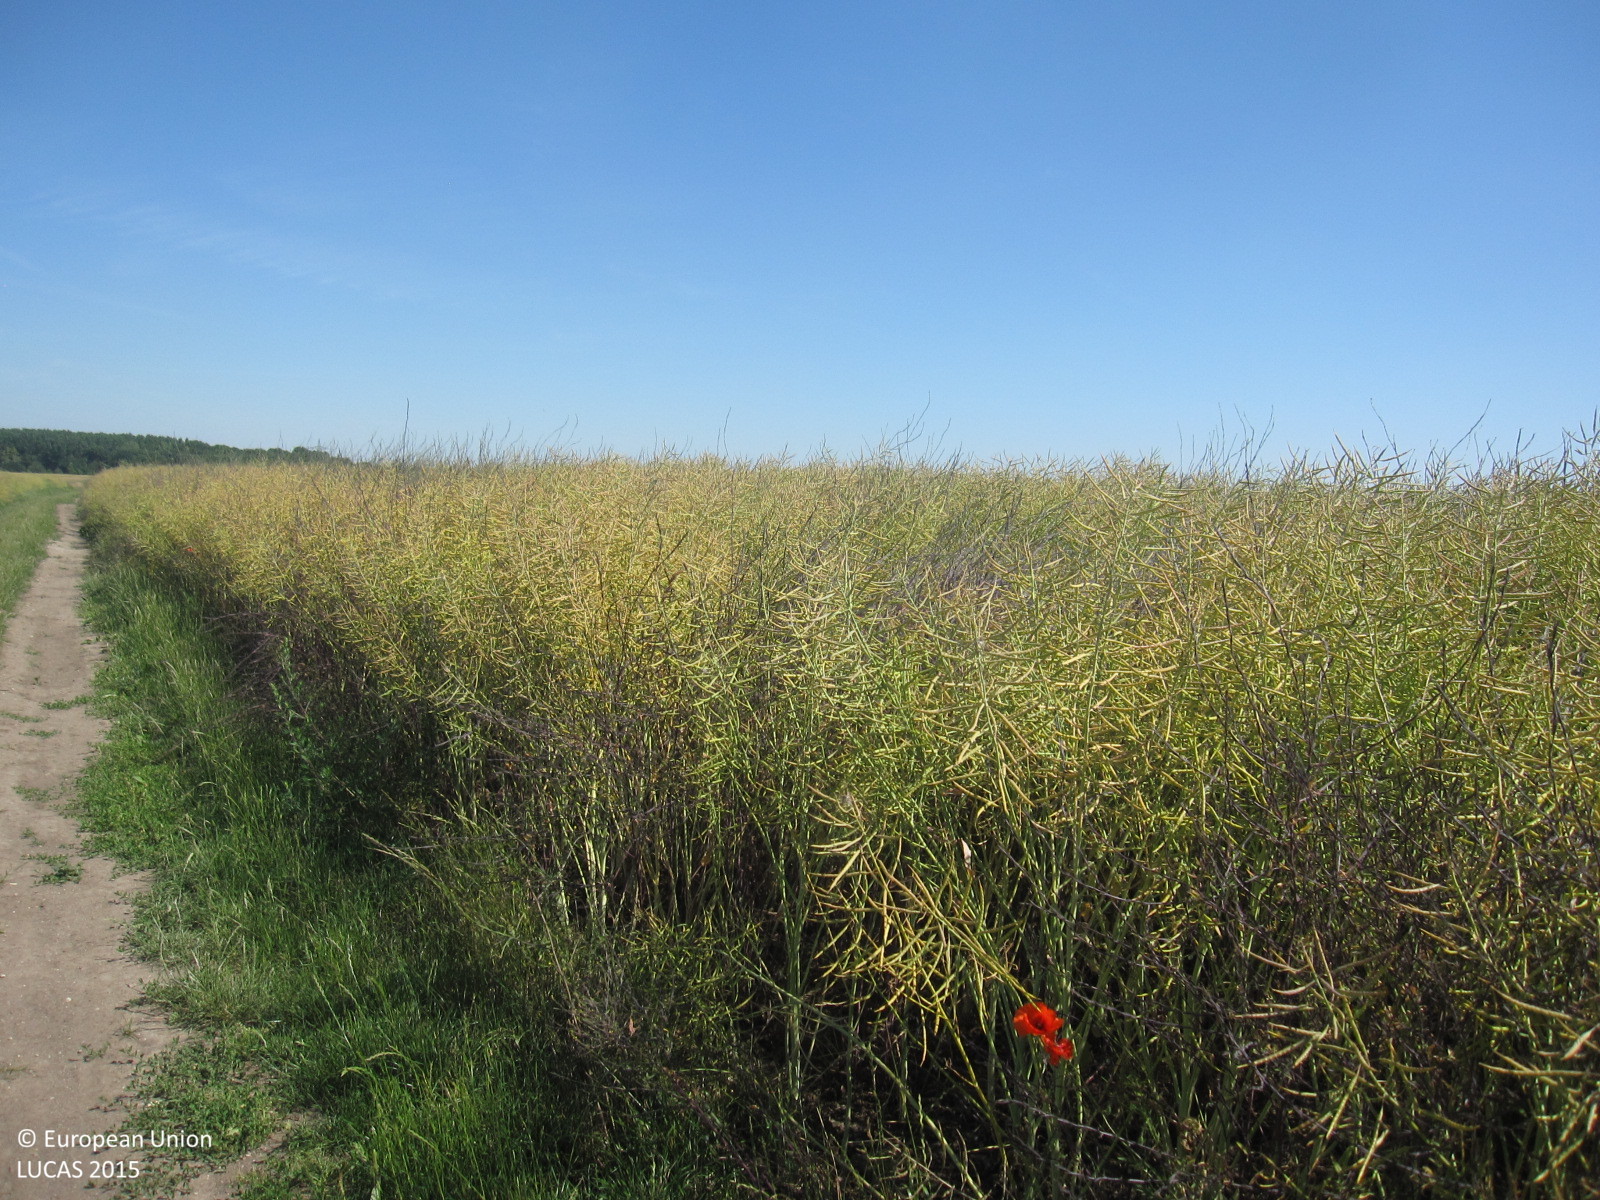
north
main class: Cropland
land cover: Rape and turnip rape
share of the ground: > 75 %
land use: Agriculture (excluding fallow land and kitchen gardens)
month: July
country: DE
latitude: 51.3322
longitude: 12.1956
